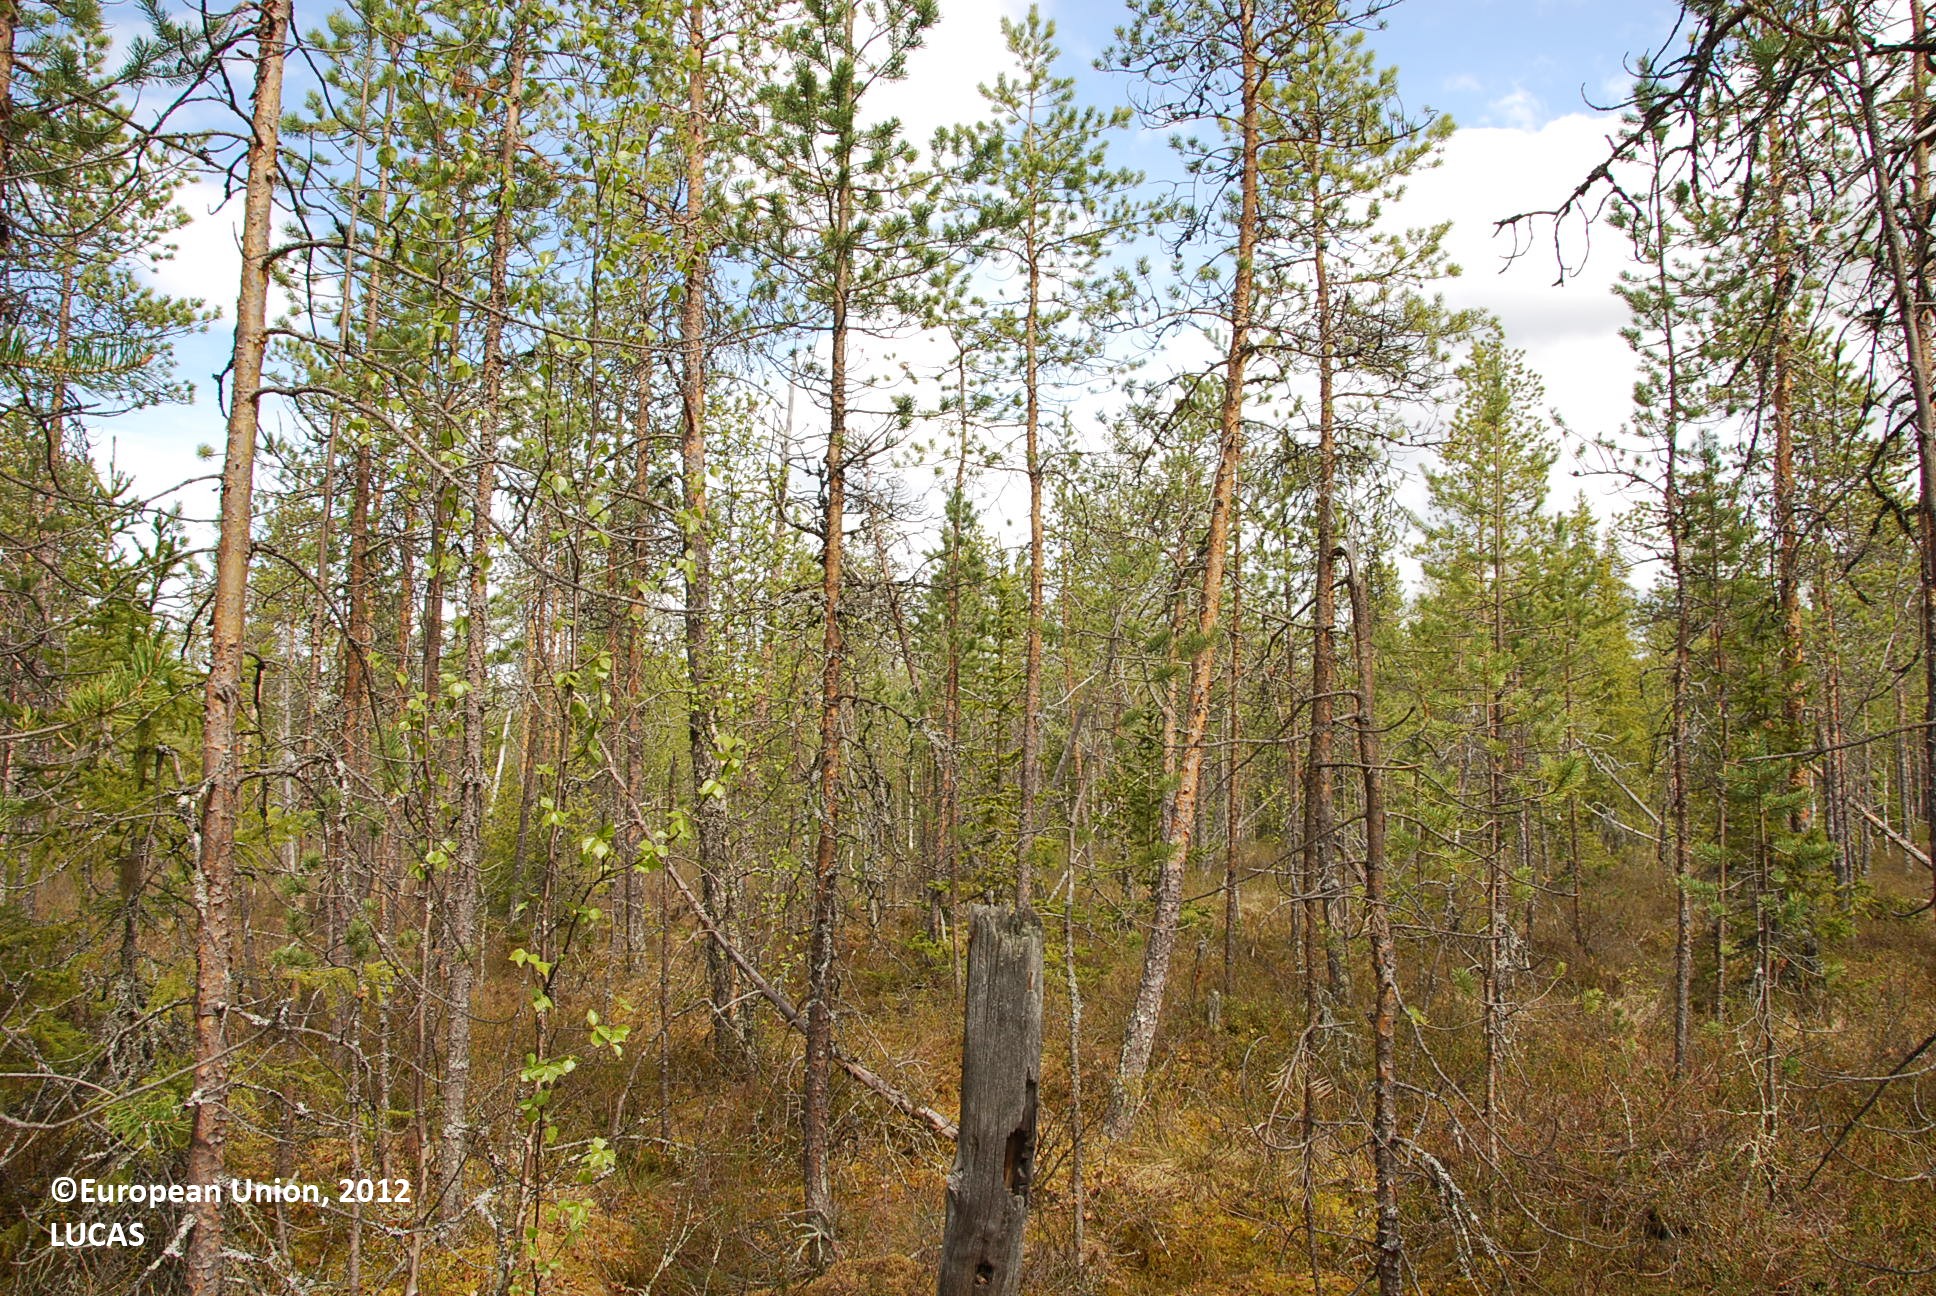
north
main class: Woodland
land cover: Pine dominated coniferous woodland
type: boreal forest
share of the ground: > 75 %
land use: Forestry
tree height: > 5 m
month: June
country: FI
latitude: 66.5791
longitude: 28.0536
